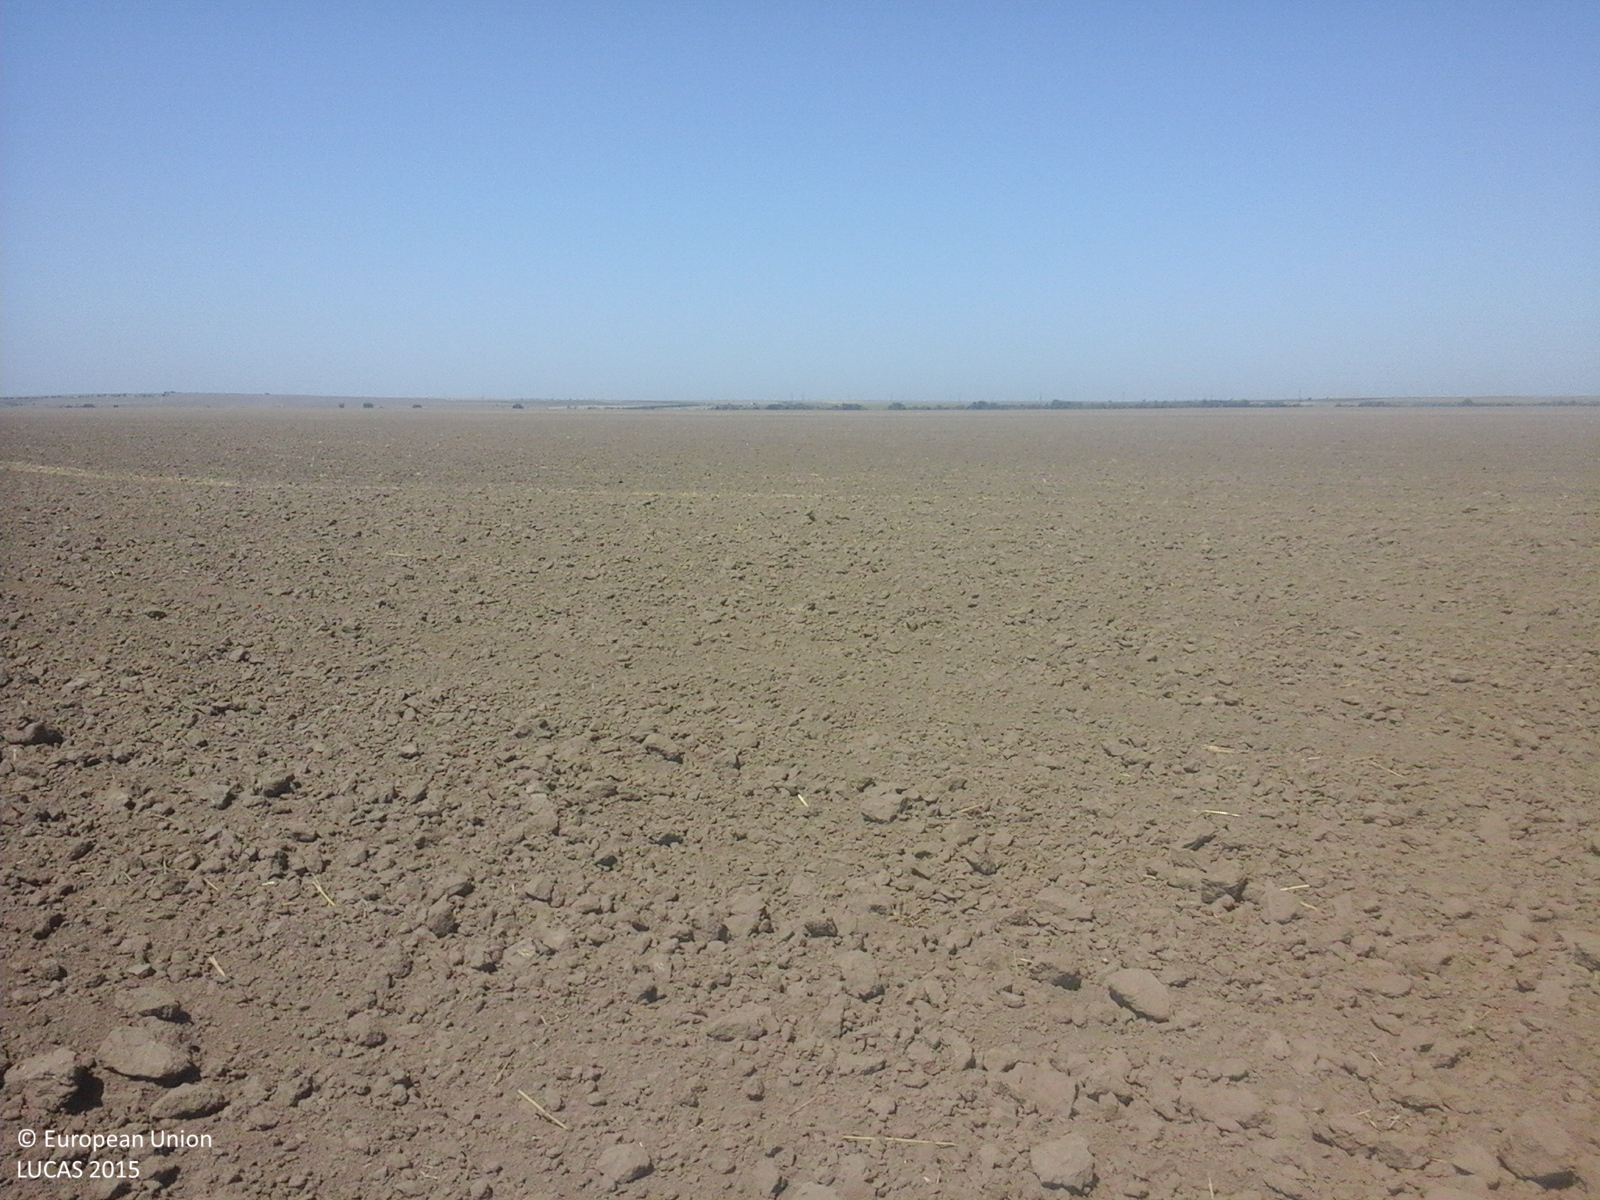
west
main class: Cropland
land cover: Barley
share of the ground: < 10 %
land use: Agriculture (excluding fallow land and kitchen gardens)
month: August
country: RO
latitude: 44.6159
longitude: 28.1468
